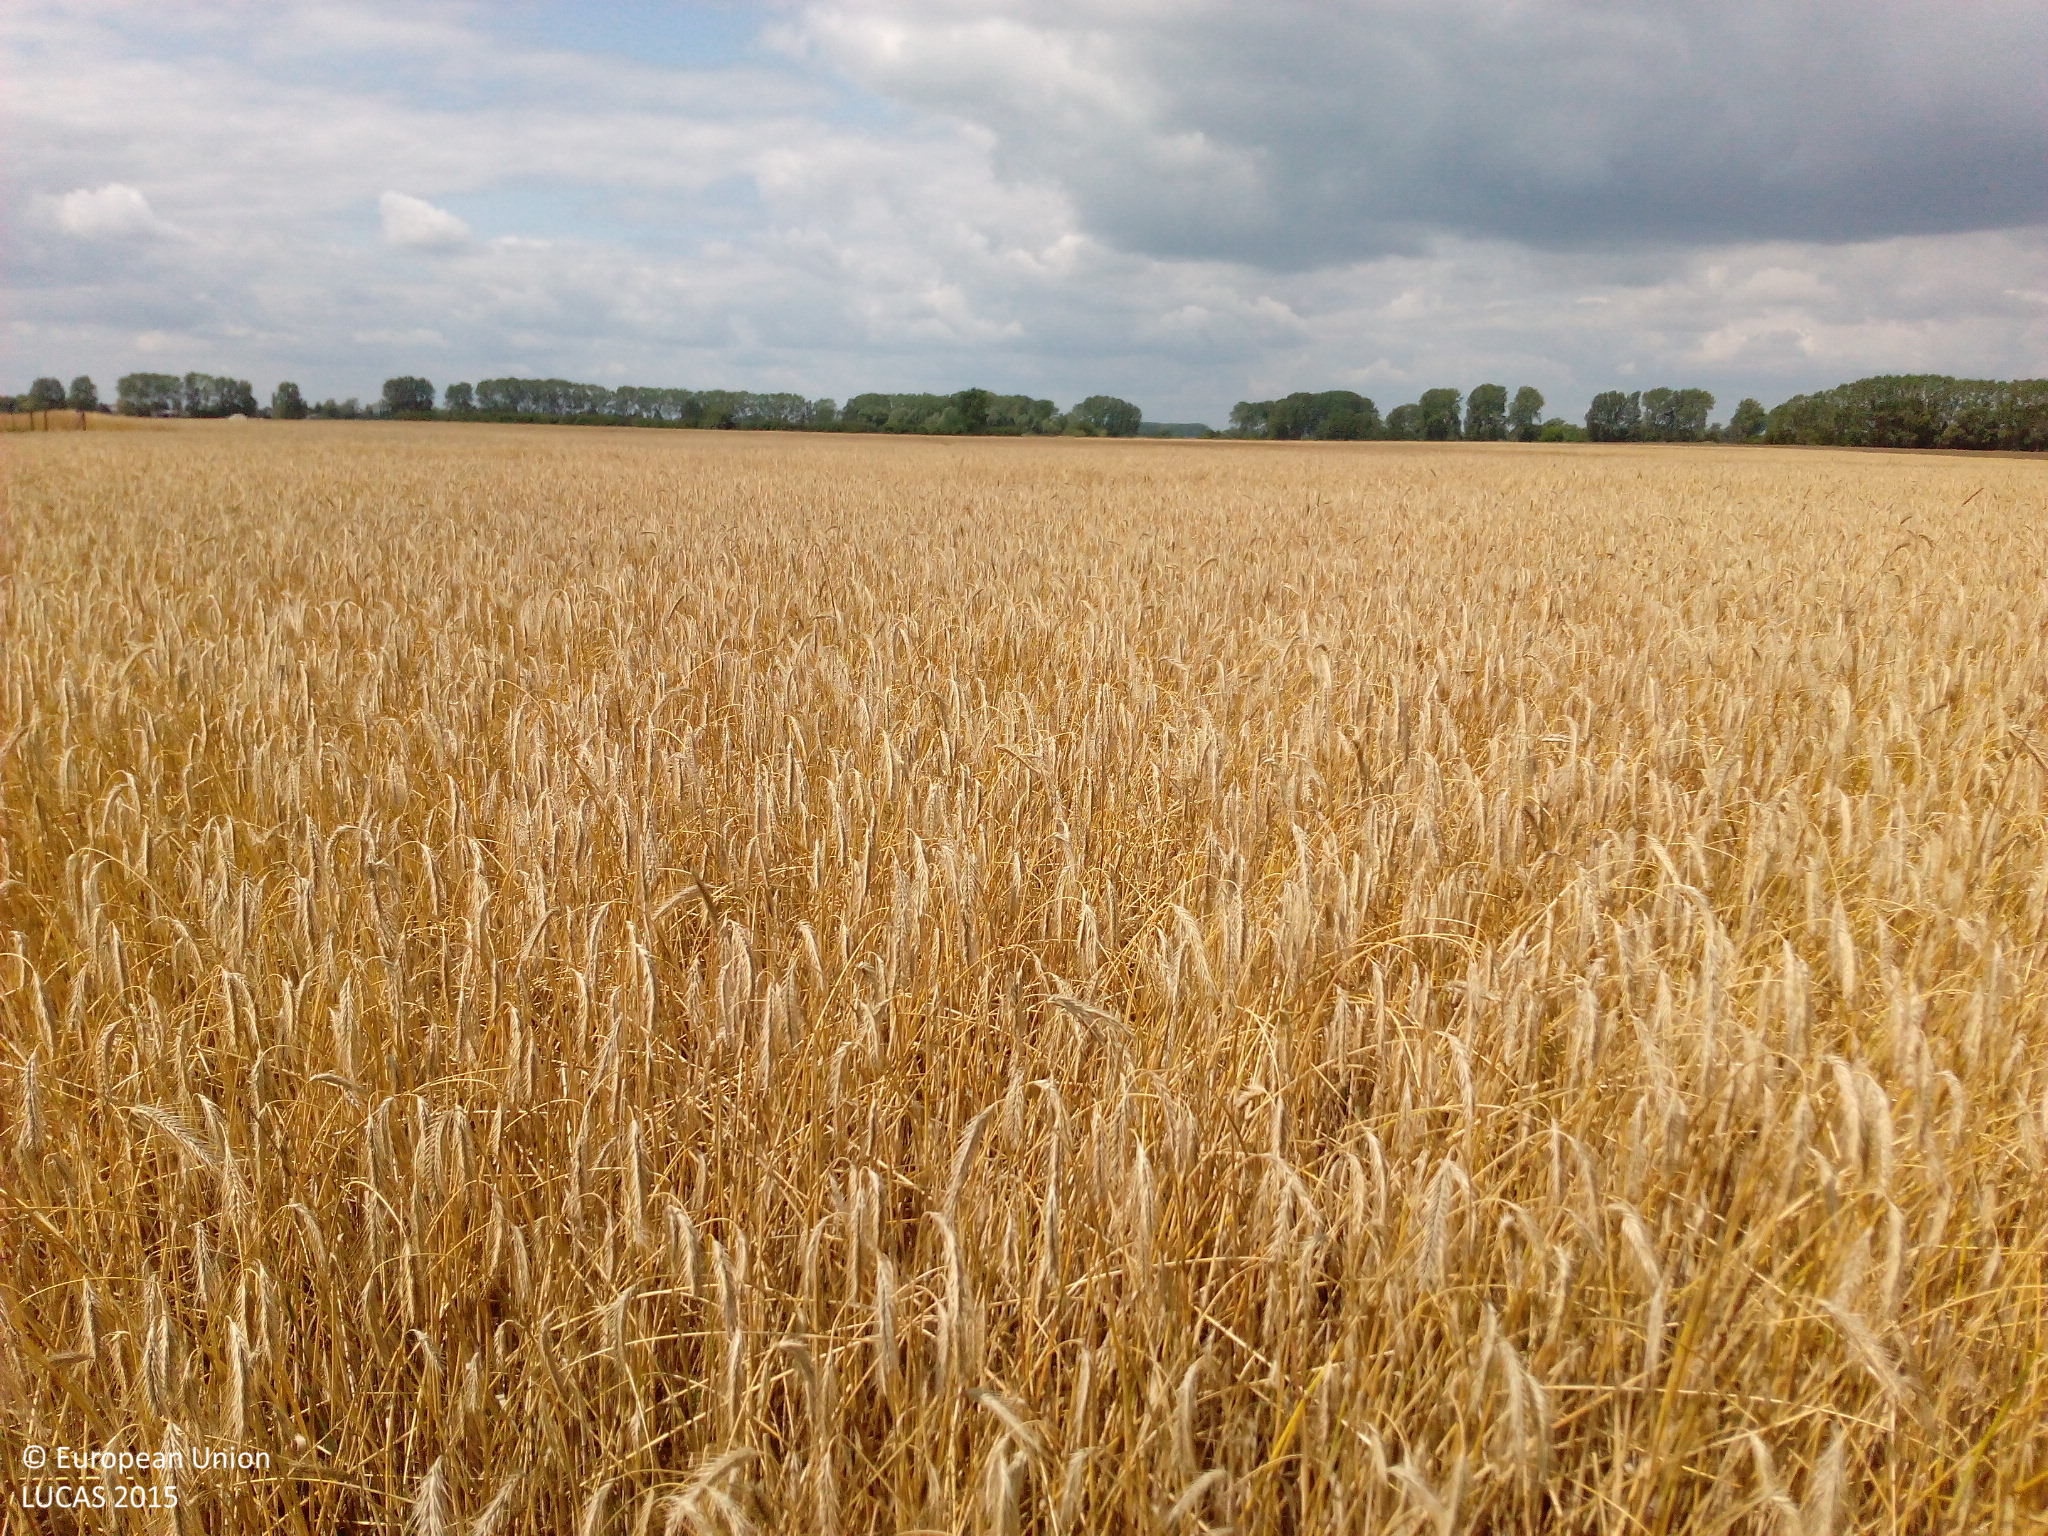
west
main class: Cropland
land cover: Rye
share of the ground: > 75 %
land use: Agriculture (excluding fallow land and kitchen gardens)
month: July
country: DE
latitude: 52.6779
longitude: 12.3512
